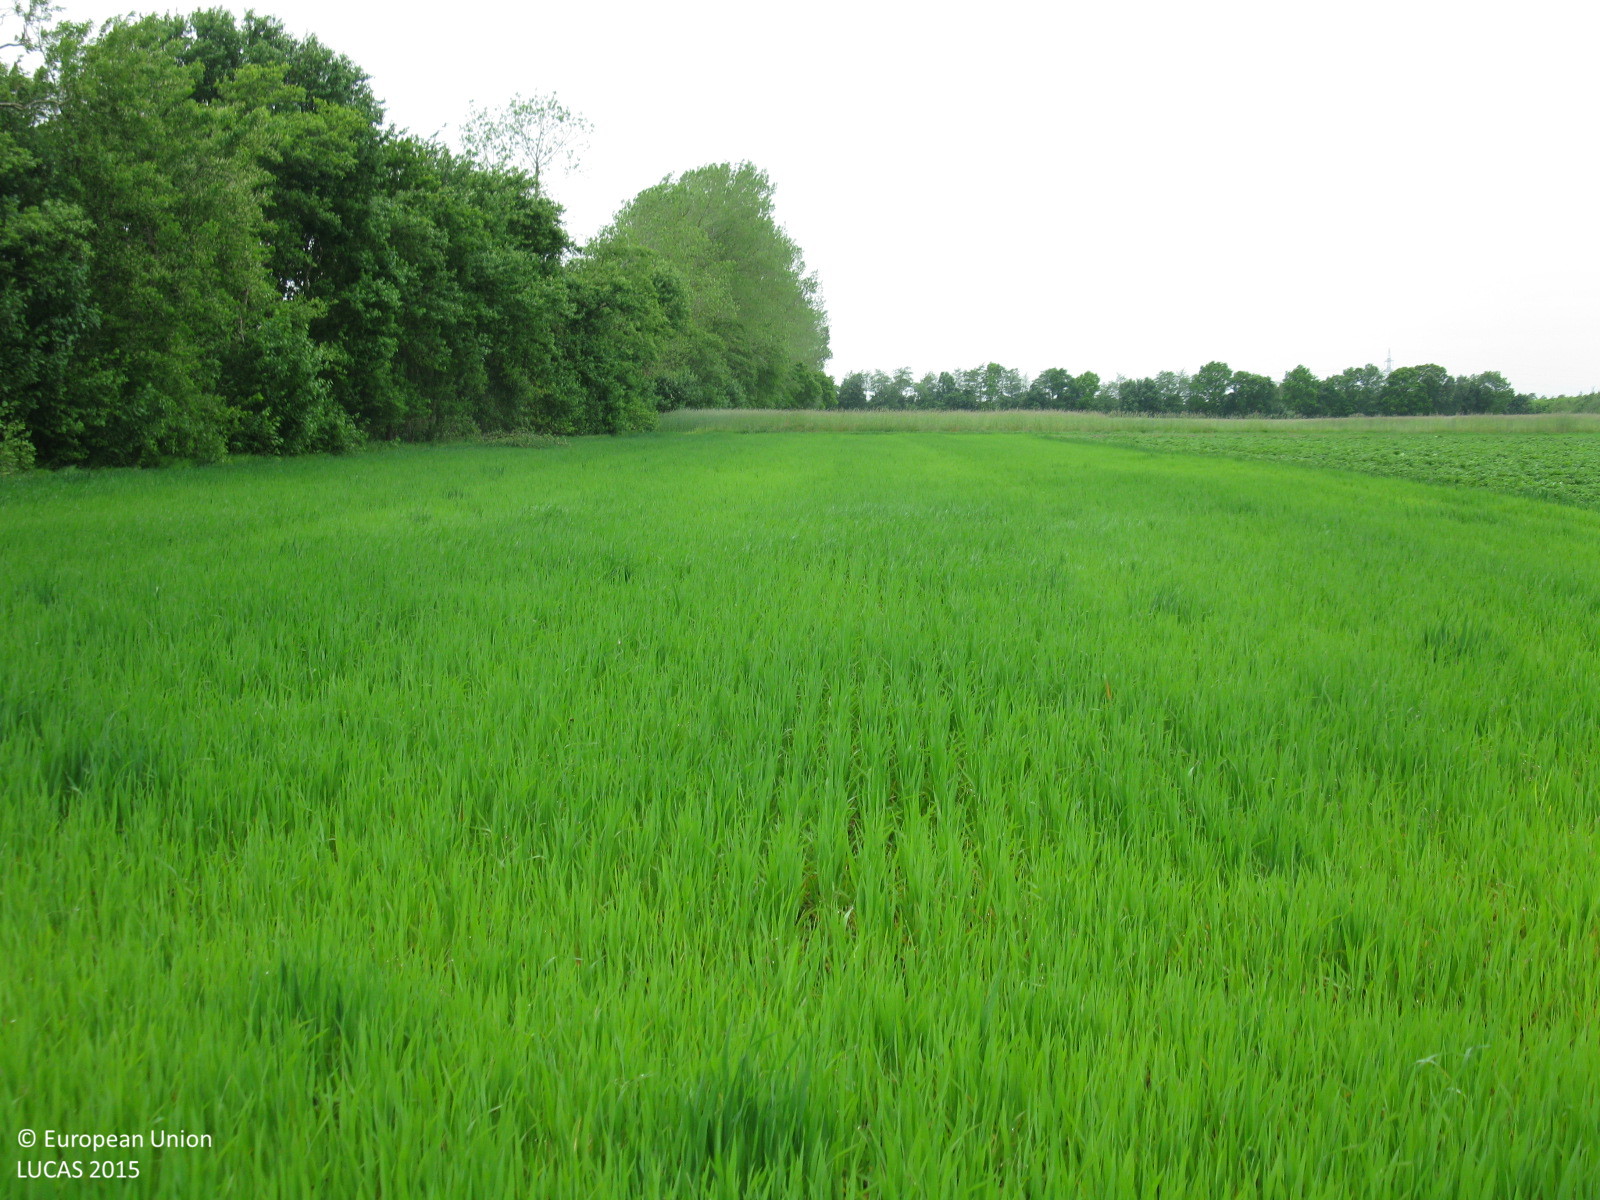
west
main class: Cropland
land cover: Oats
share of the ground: > 75 %
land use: Agriculture (excluding fallow land and kitchen gardens)
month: June
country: DE
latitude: 53.0322
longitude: 7.3910
